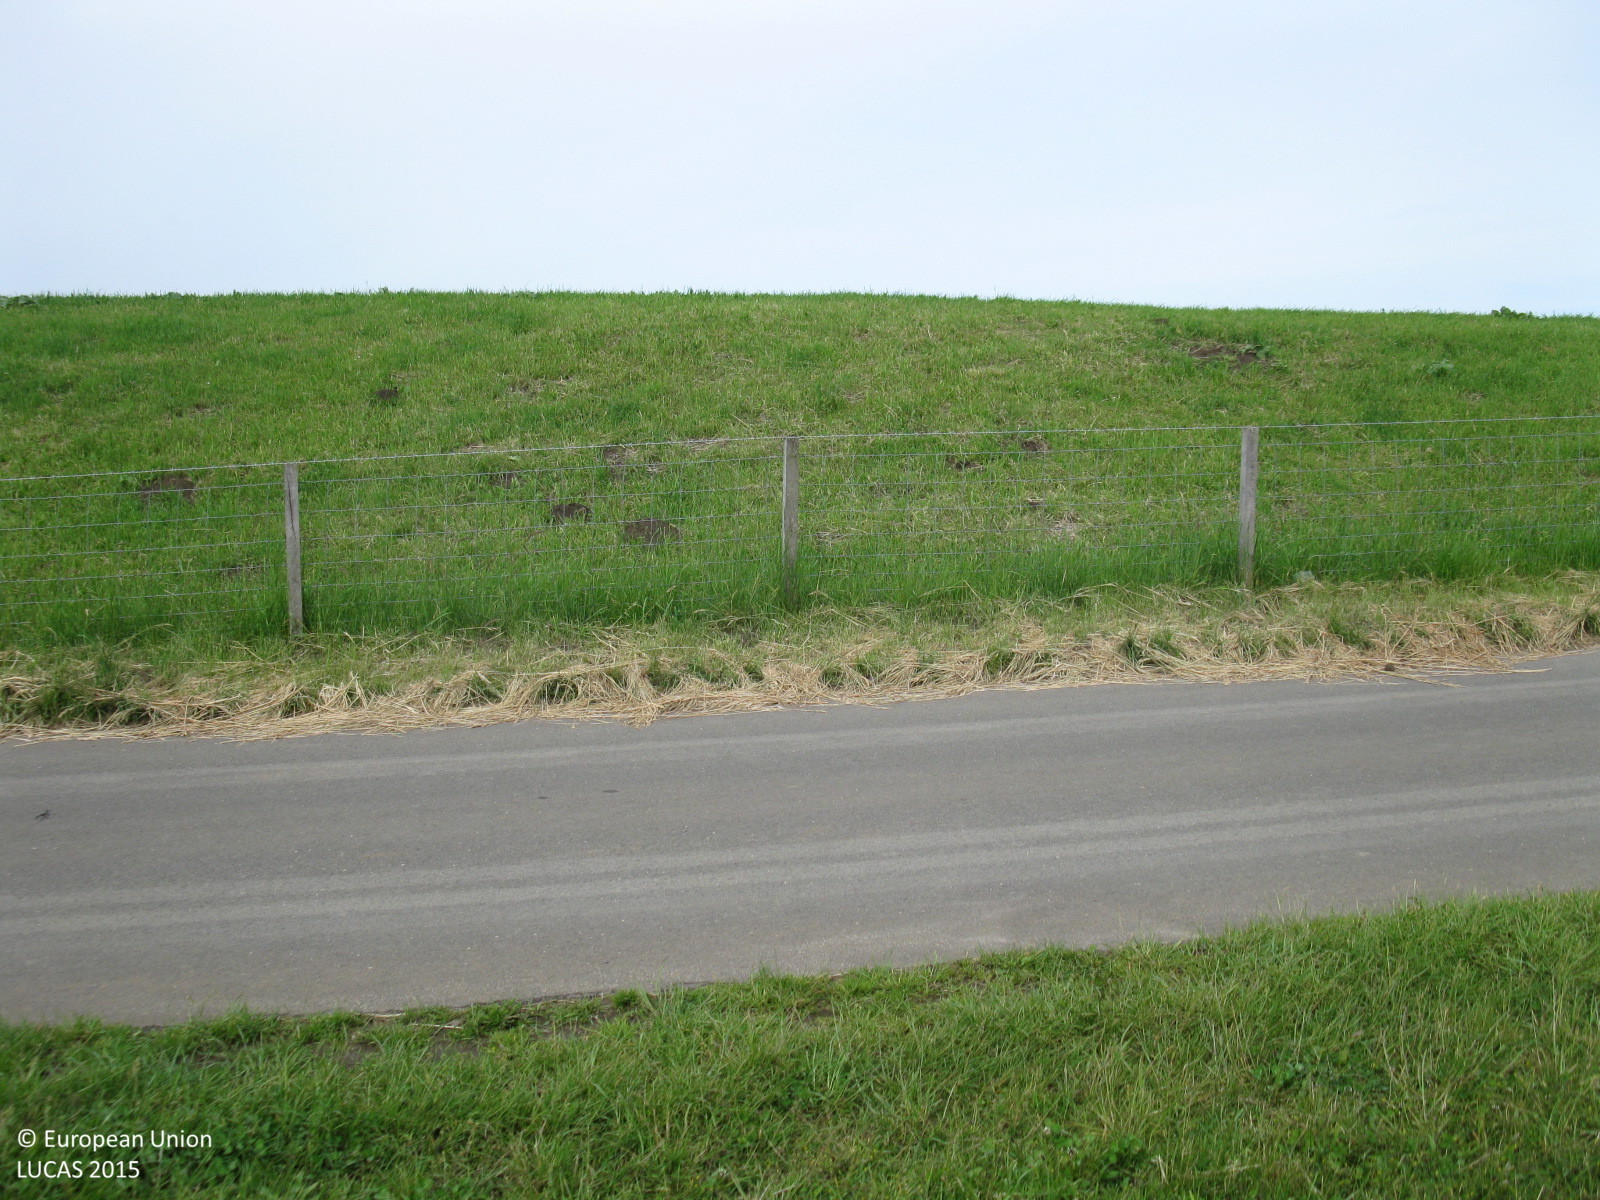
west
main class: Grassland
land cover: Grassland without tree/shrub cover
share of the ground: > 75 %
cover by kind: herbaceous plants 100 %
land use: Protection infrastructures
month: June
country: DE
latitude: 53.0841
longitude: 7.2982
